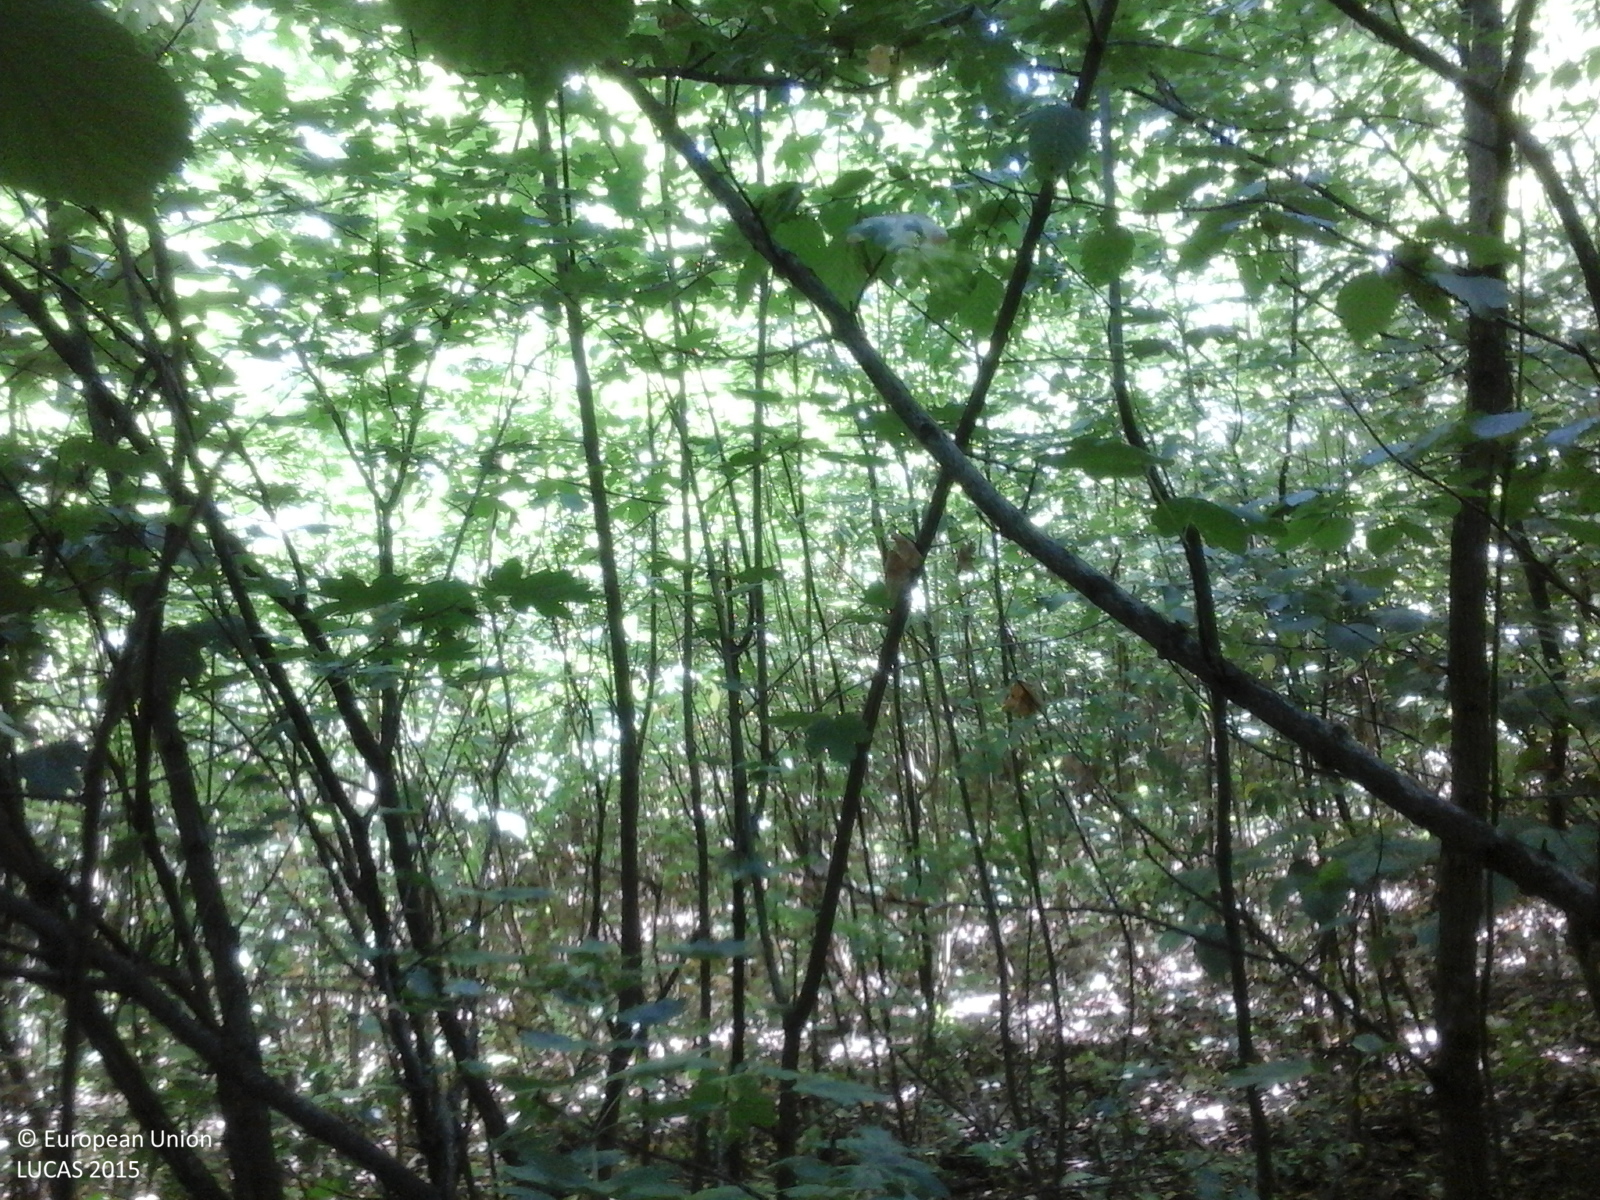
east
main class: Woodland
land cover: Broadleaved woodland
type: thermophilous deciduous forest
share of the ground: > 75 %
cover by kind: broadleaved forest trees 100 %
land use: Forestry
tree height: > 5 m
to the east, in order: Broadleaved woodland; Tracks; Broadleaved woodland; Ditches and canals; Broadleaved woodland
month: June
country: RO
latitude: 47.0862
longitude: 27.3805
